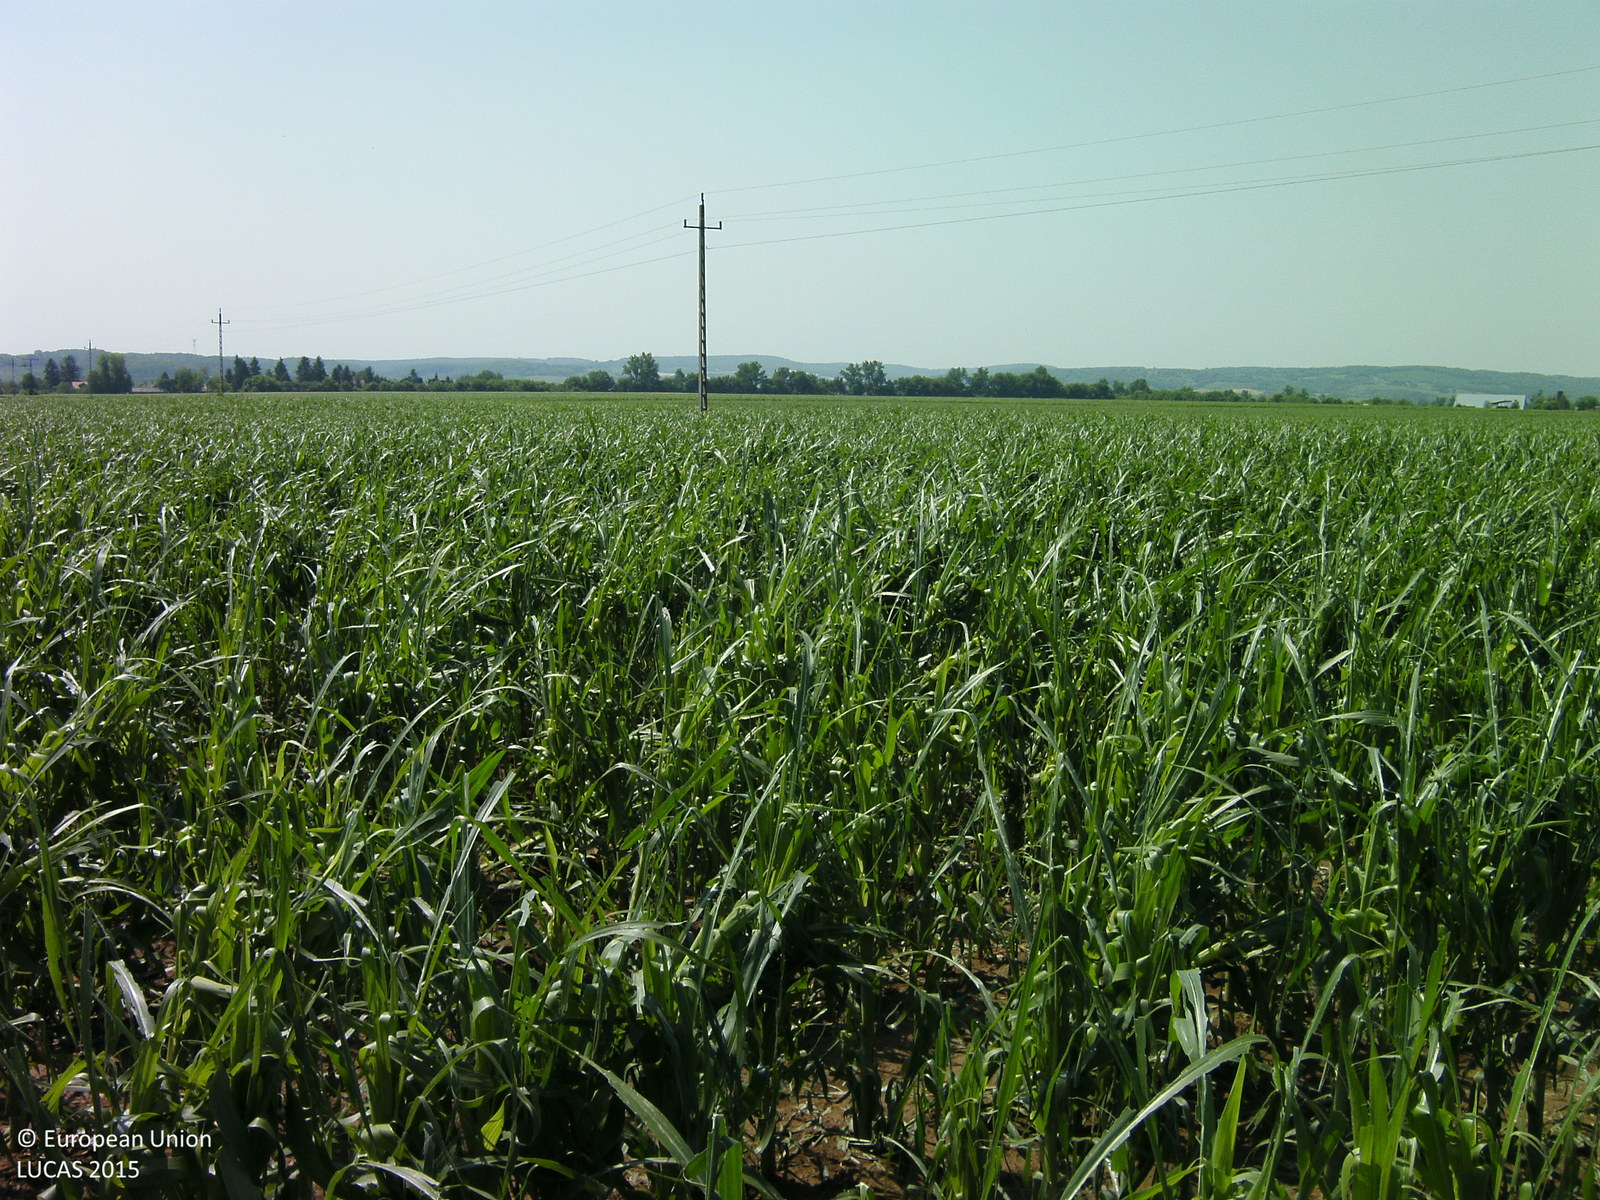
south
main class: Cropland
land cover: Maize
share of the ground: 50 - 75 %
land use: Agriculture (excluding fallow land and kitchen gardens)
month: June
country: HU
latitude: 46.3748
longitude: 18.0284
